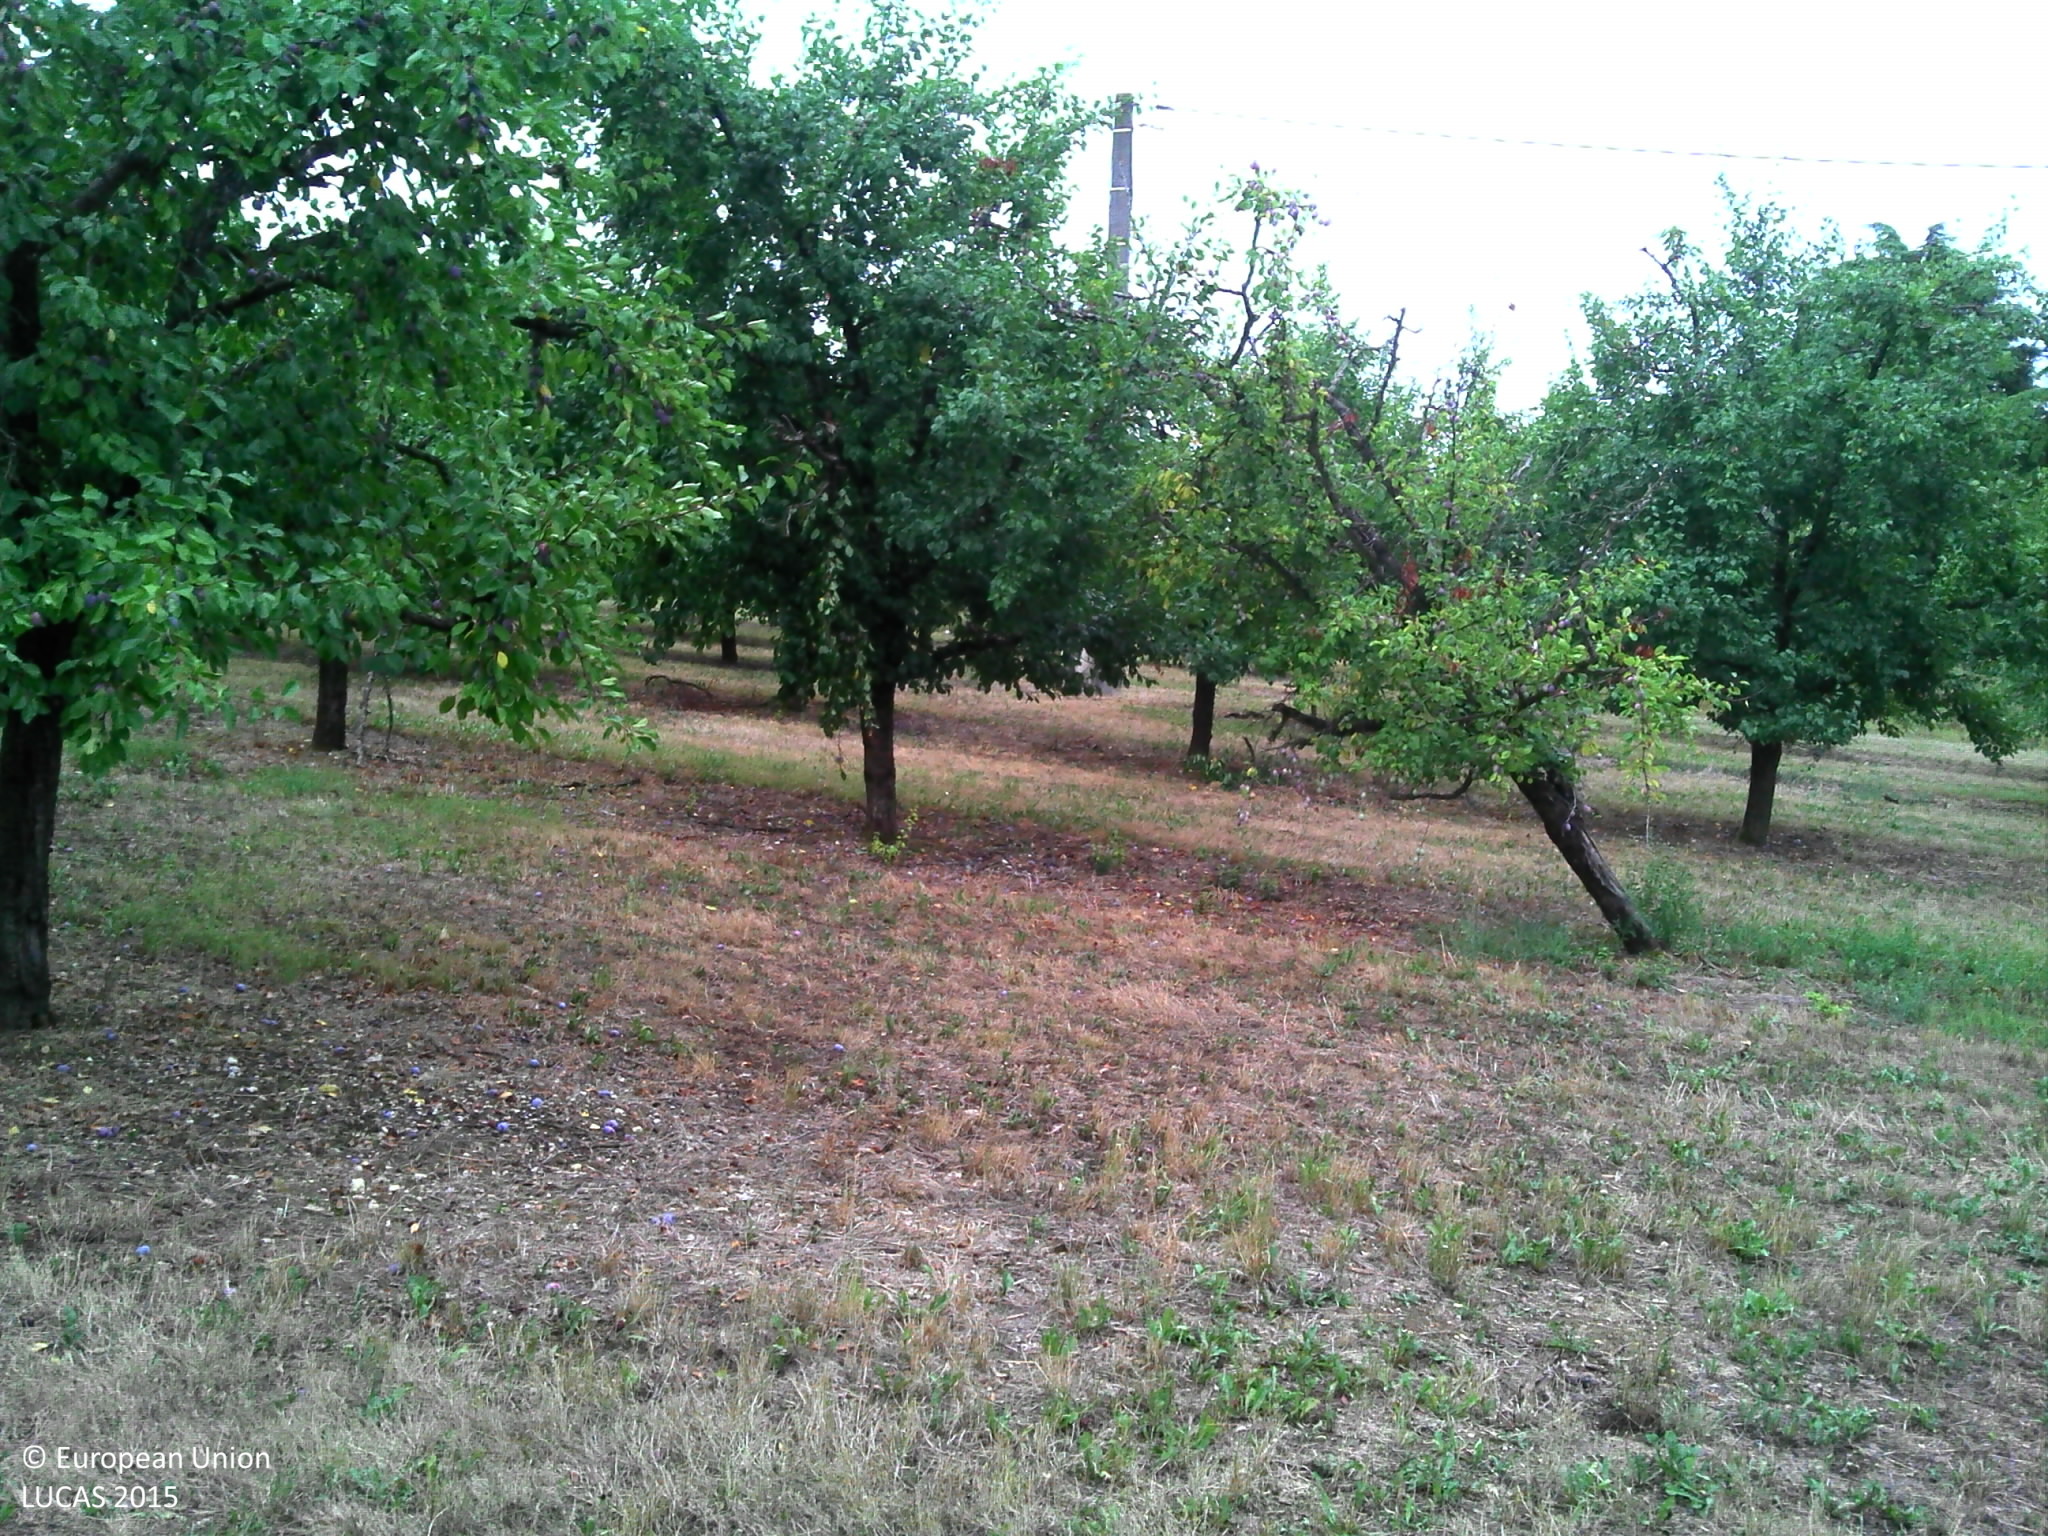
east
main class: Woodland
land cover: Broadleaved woodland
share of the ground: > 75 %
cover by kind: broadleaved forest trees 70 %, shrubs 30 %
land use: Semi-natural and natural areas not in use
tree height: > 5 m
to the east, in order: Broadleaved woodland; Grass margins; Other fruit trees and berries; Electric lines; Other fruit trees and berries; Fences; Grassland with sparse tree/shrub cover; Fences; Grass margins; Other fruit trees and berries; Electric lines; Other fruit trees and berries; Artificial constructions in urban areas; Spontaneously vegetated surfaces; Shrubland with sparse tree cover; Electric lines; Other fruit trees and berries
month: July
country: FR
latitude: 44.2935
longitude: 0.6827
